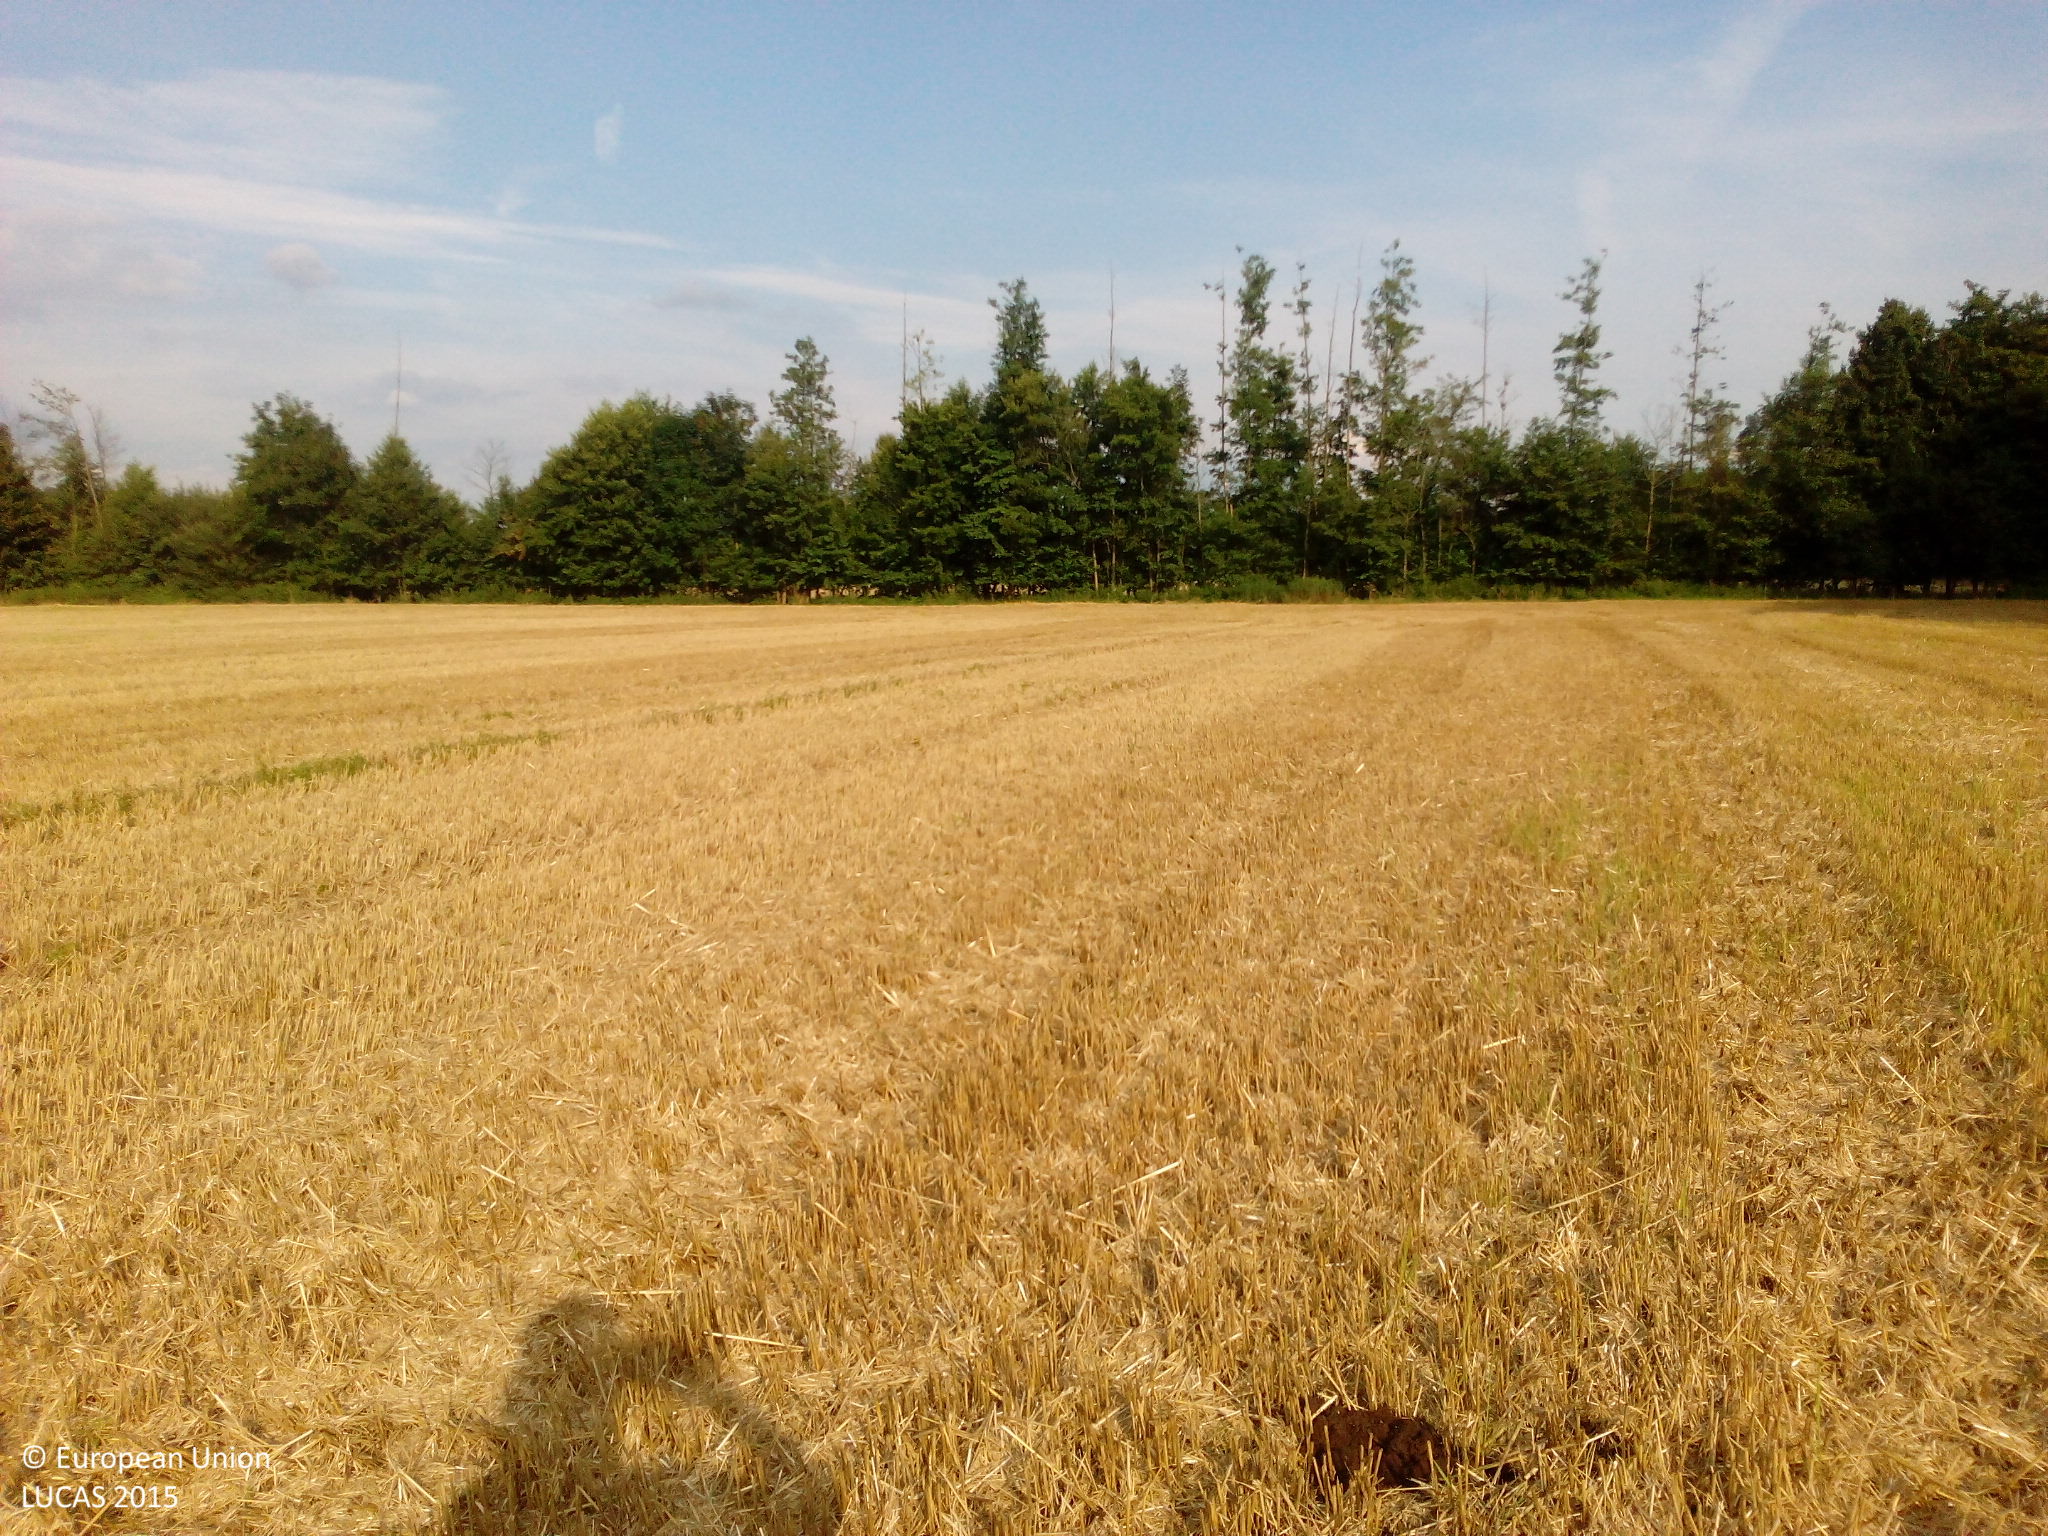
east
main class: Cropland
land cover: Barley
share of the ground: 50 - 75 %
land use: Agriculture (excluding fallow land and kitchen gardens)
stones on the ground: < 10 %
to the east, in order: Barley; Broadleaved woodland; Ditches and canals; Broadleaved woodland; Barley
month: August
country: DE
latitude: 52.1094
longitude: 8.0292
